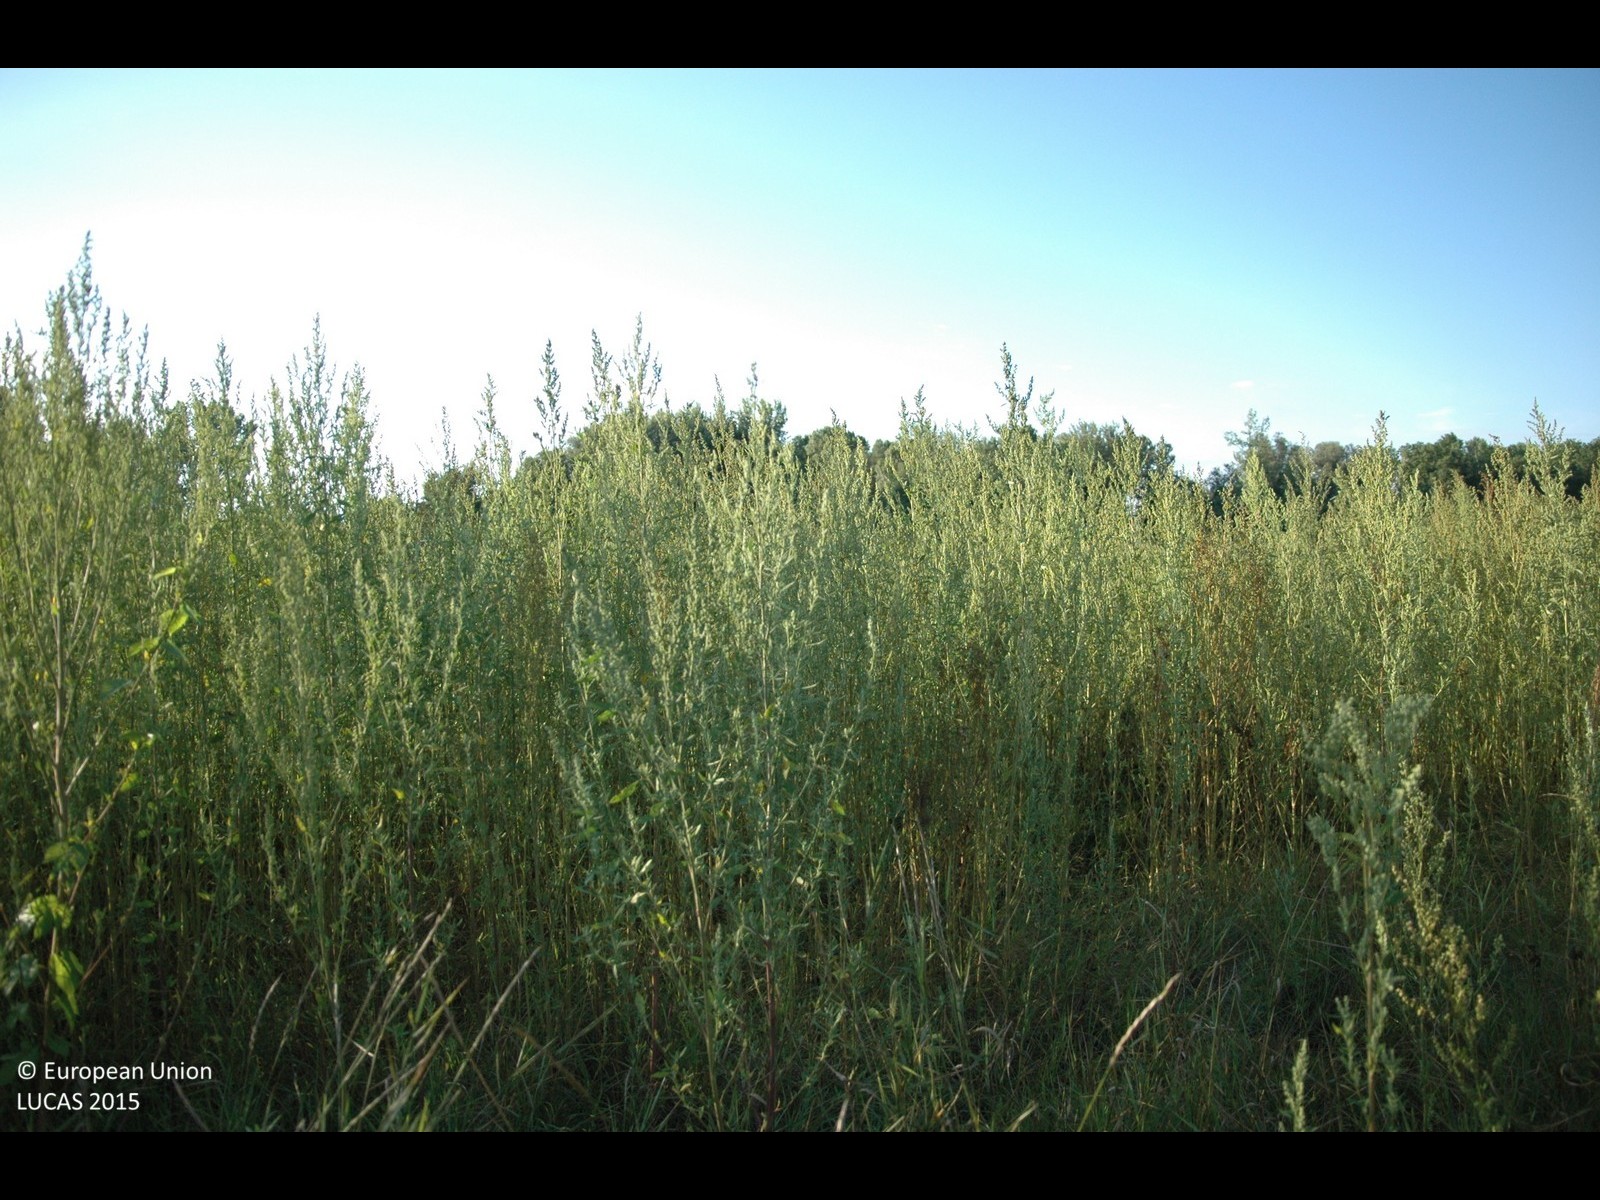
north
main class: Grassland
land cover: Grassland without tree/shrub cover
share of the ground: > 75 %
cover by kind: herbaceous plants 100 %
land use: Abandoned areas
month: July
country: HR
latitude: 46.2604
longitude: 16.8125
